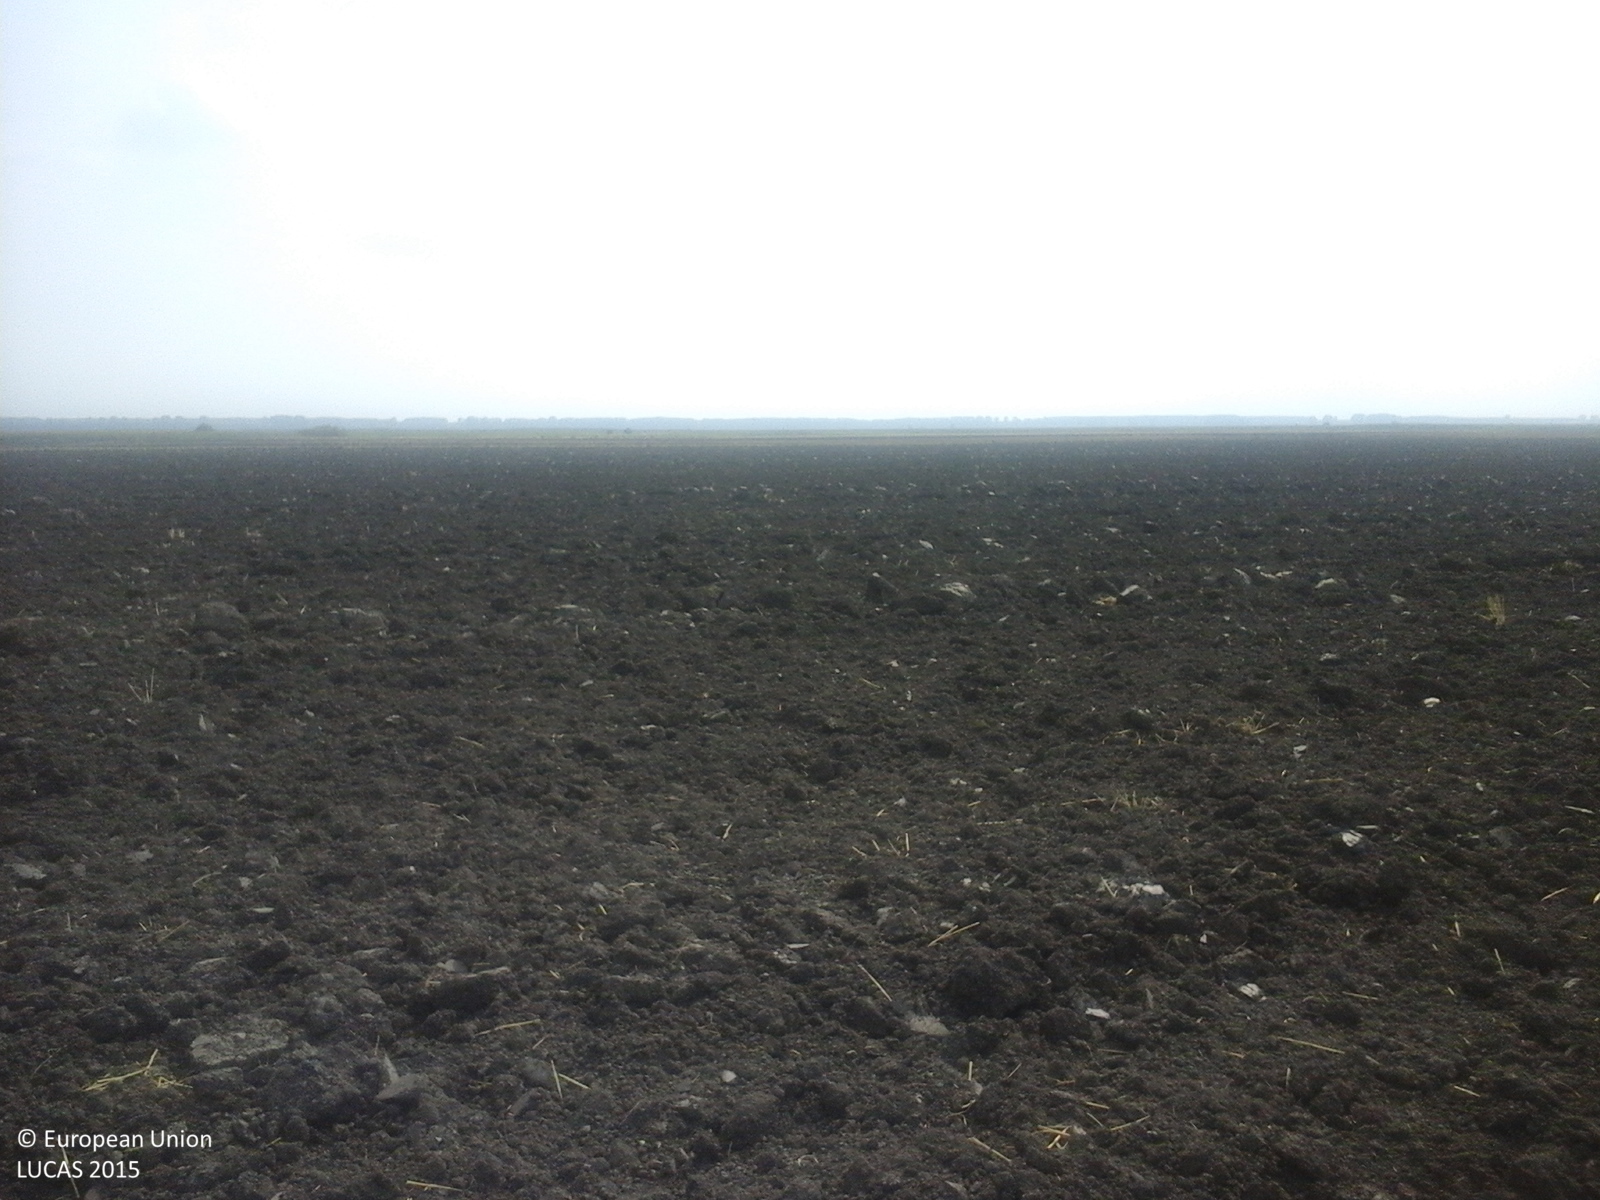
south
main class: Cropland
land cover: Common wheat
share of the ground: < 10 %
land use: Agriculture (excluding fallow land and kitchen gardens)
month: July
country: RO
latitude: 45.2910
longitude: 28.0839
